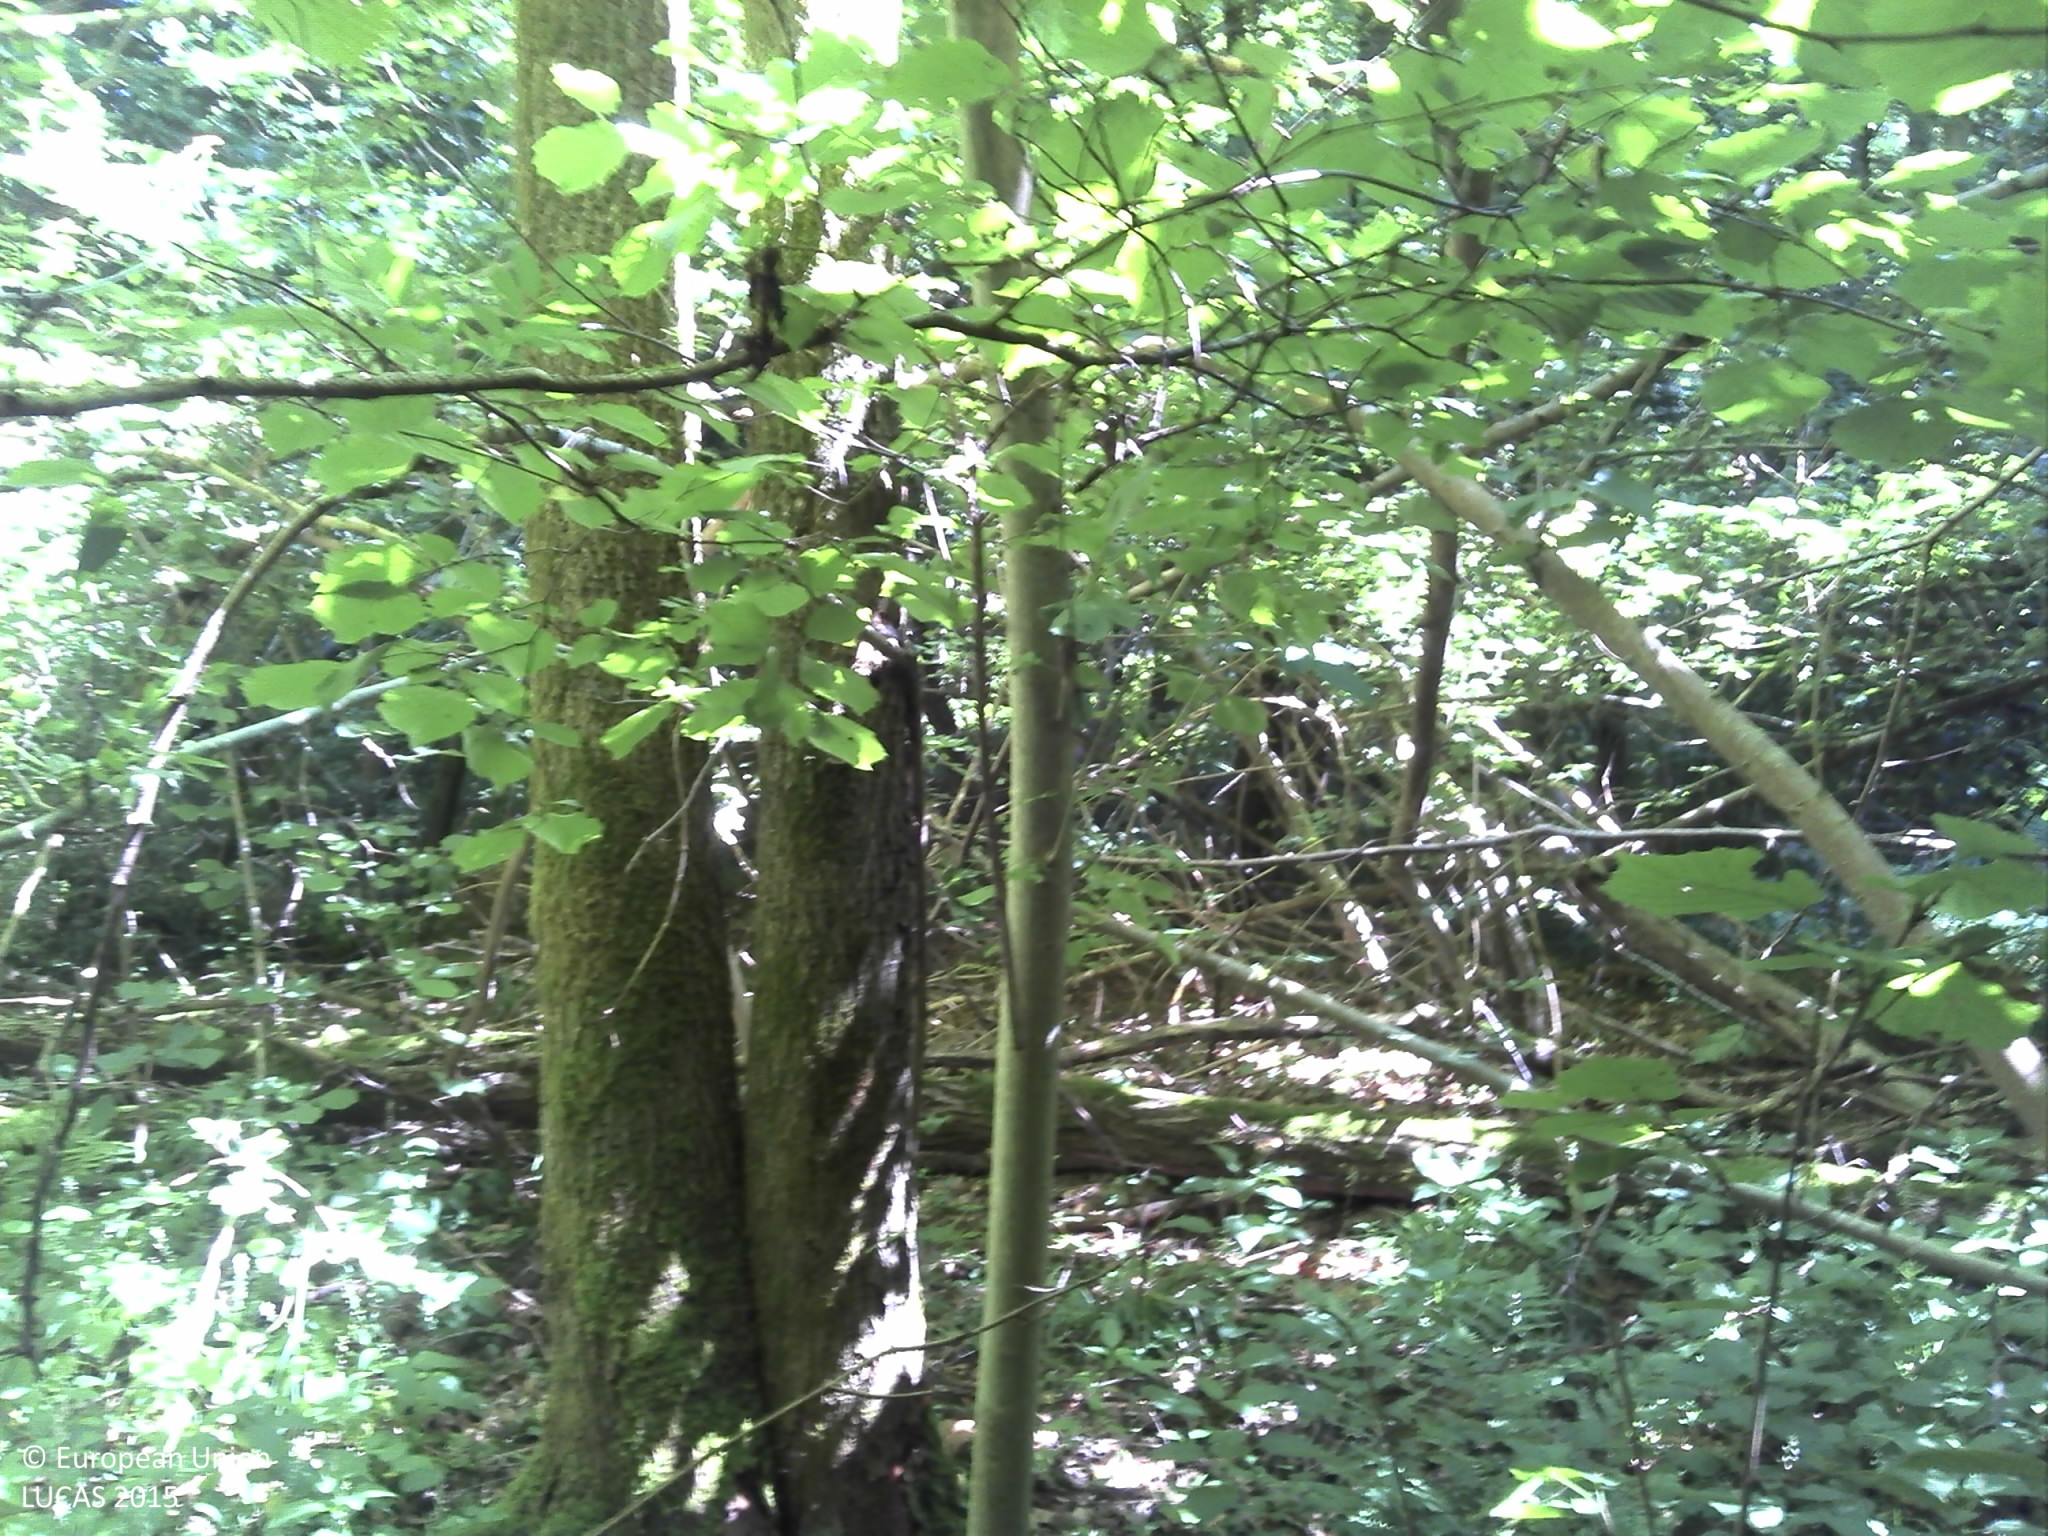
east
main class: Woodland
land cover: Broadleaved woodland
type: beech forest
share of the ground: > 75 %
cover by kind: broadleaved forest trees 60 %, herbaceous plants 30 %, lichens and mosses 5 %, consolidated bare surface 5 %
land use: Forestry
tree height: > 5 m
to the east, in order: Broadleaved woodland; Fences; Broadleaved woodland; Fences; Broadleaved woodland; Grassland without tree/shrub cover; Electric lines; Grassland without tree/shrub cover; Fences; Grassland without tree/shrub cover
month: July
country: FR
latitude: 49.5386
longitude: 4.7042
